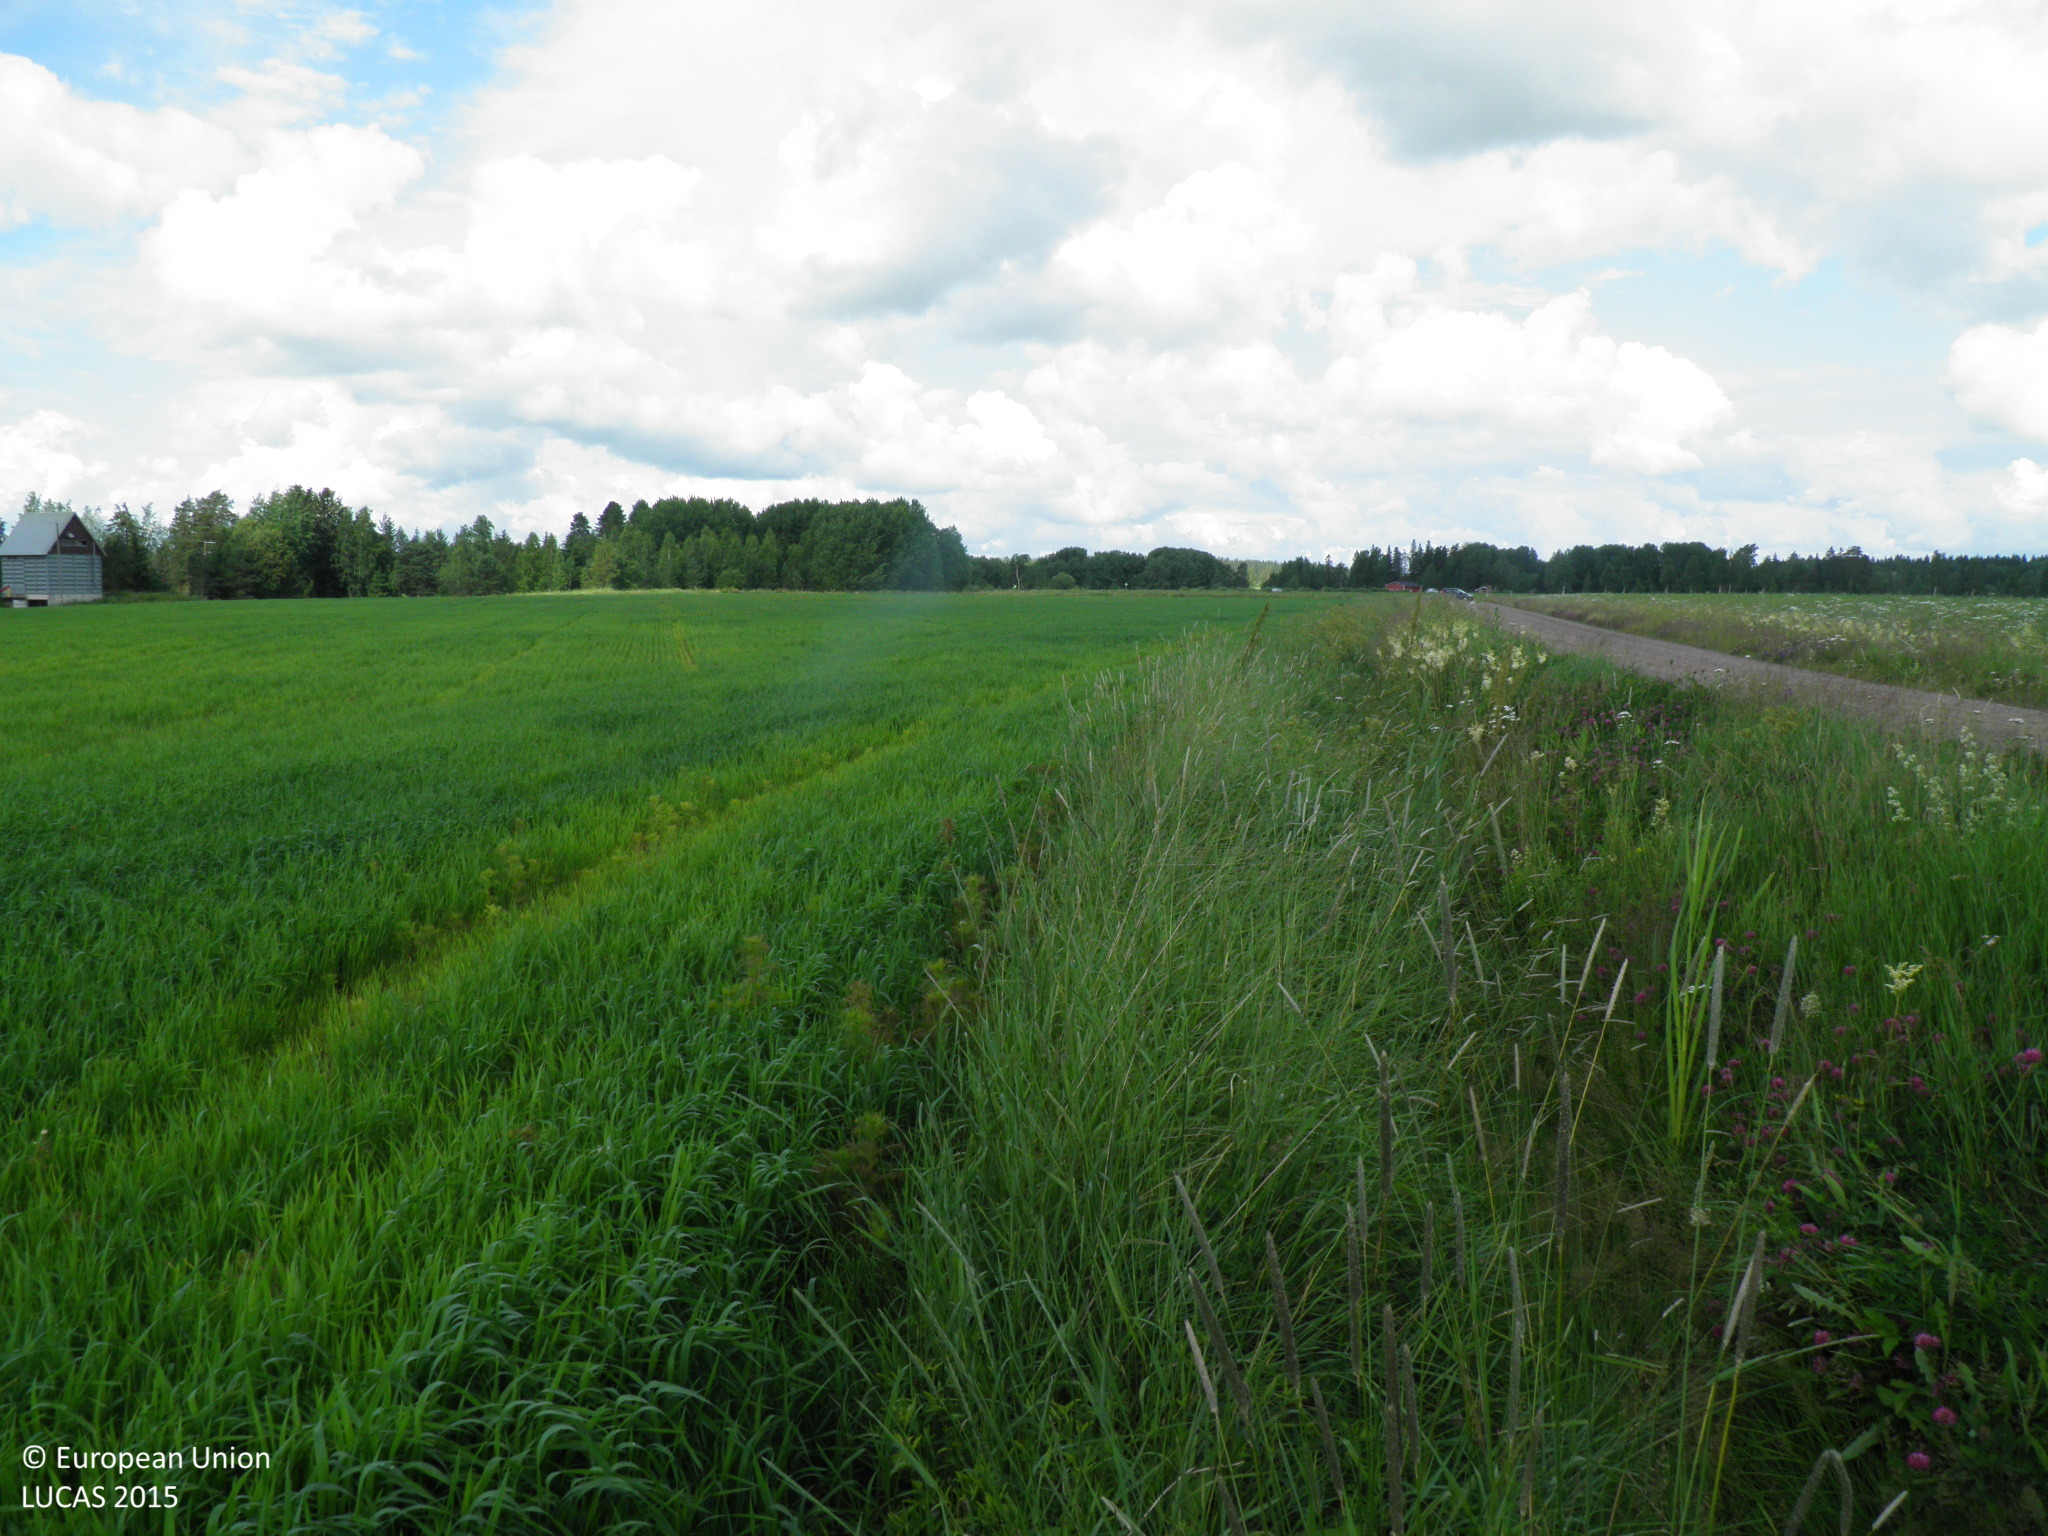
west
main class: Cropland
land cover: Common wheat
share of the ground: > 75 %
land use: Agriculture (excluding fallow land and kitchen gardens)
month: July
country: FI
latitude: 60.8289
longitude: 22.8934
